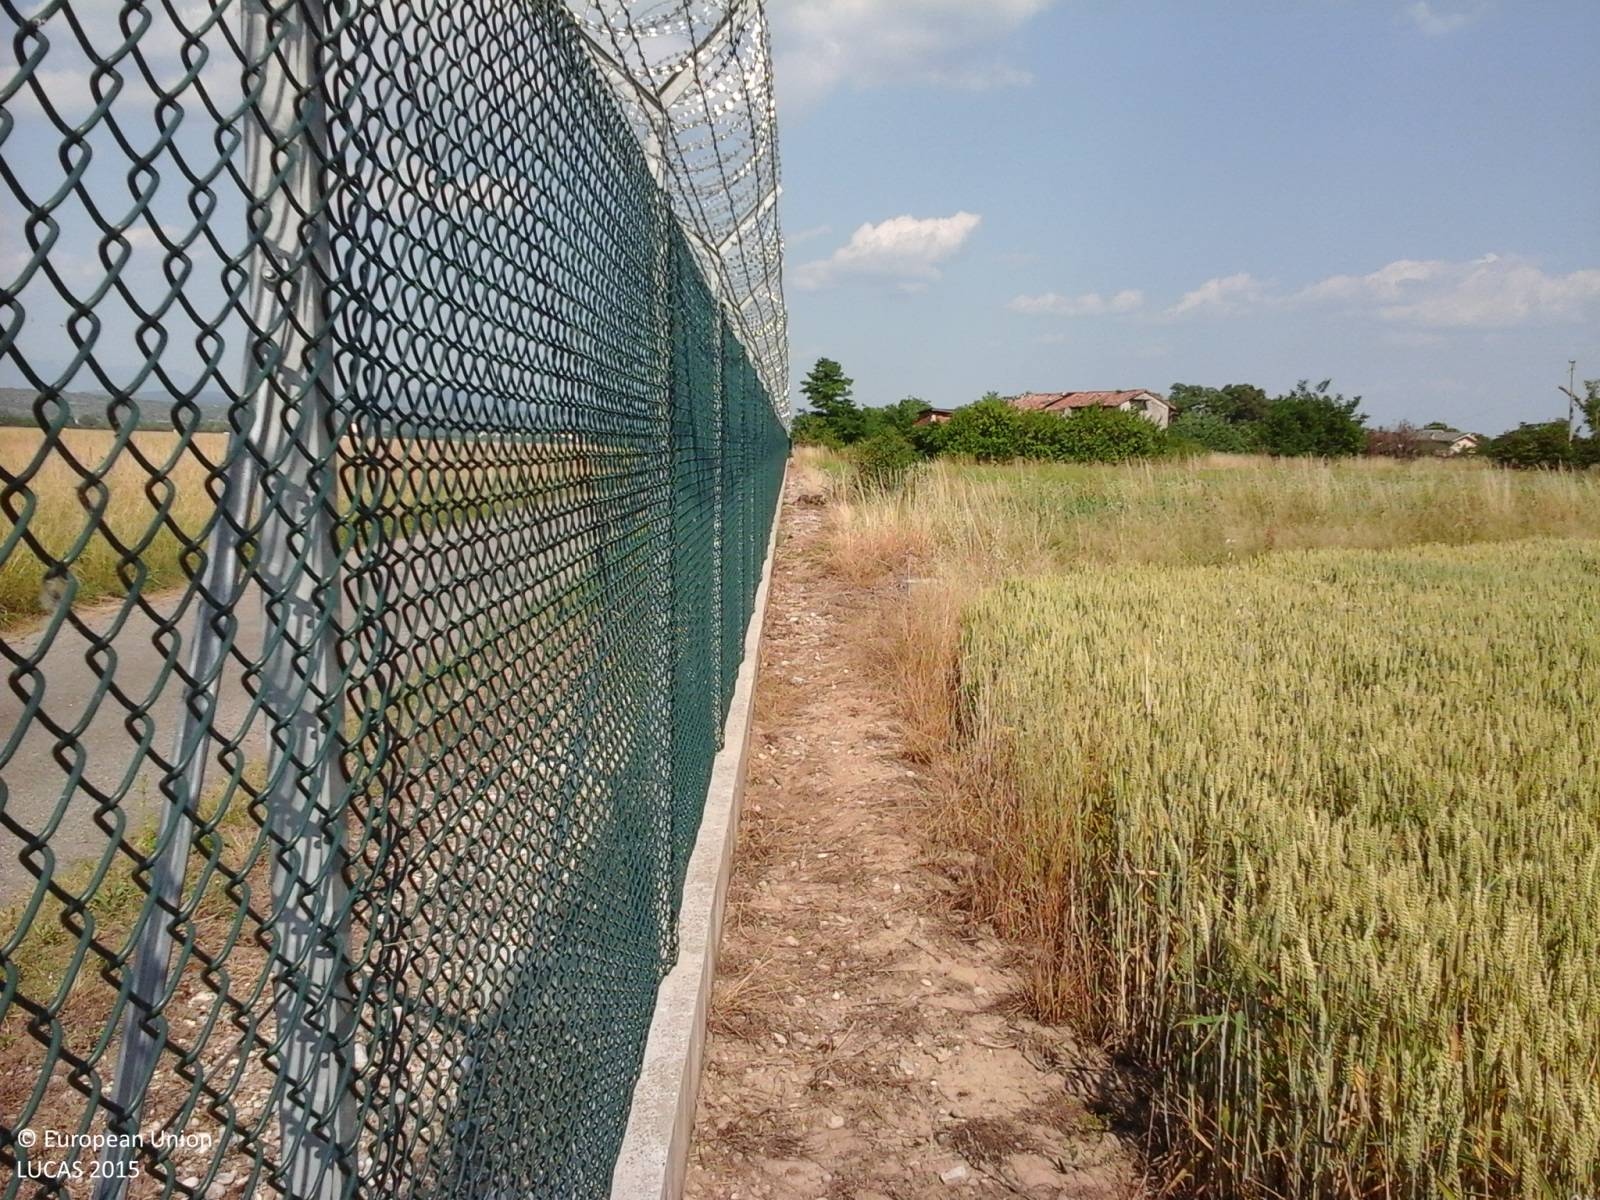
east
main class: Grassland
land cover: Grassland without tree/shrub cover
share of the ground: > 75 %
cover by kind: herbaceous plants 100 %
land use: Air transport
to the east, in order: Grassland without tree/shrub cover
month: June
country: IT
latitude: 45.8265
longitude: 13.4586
